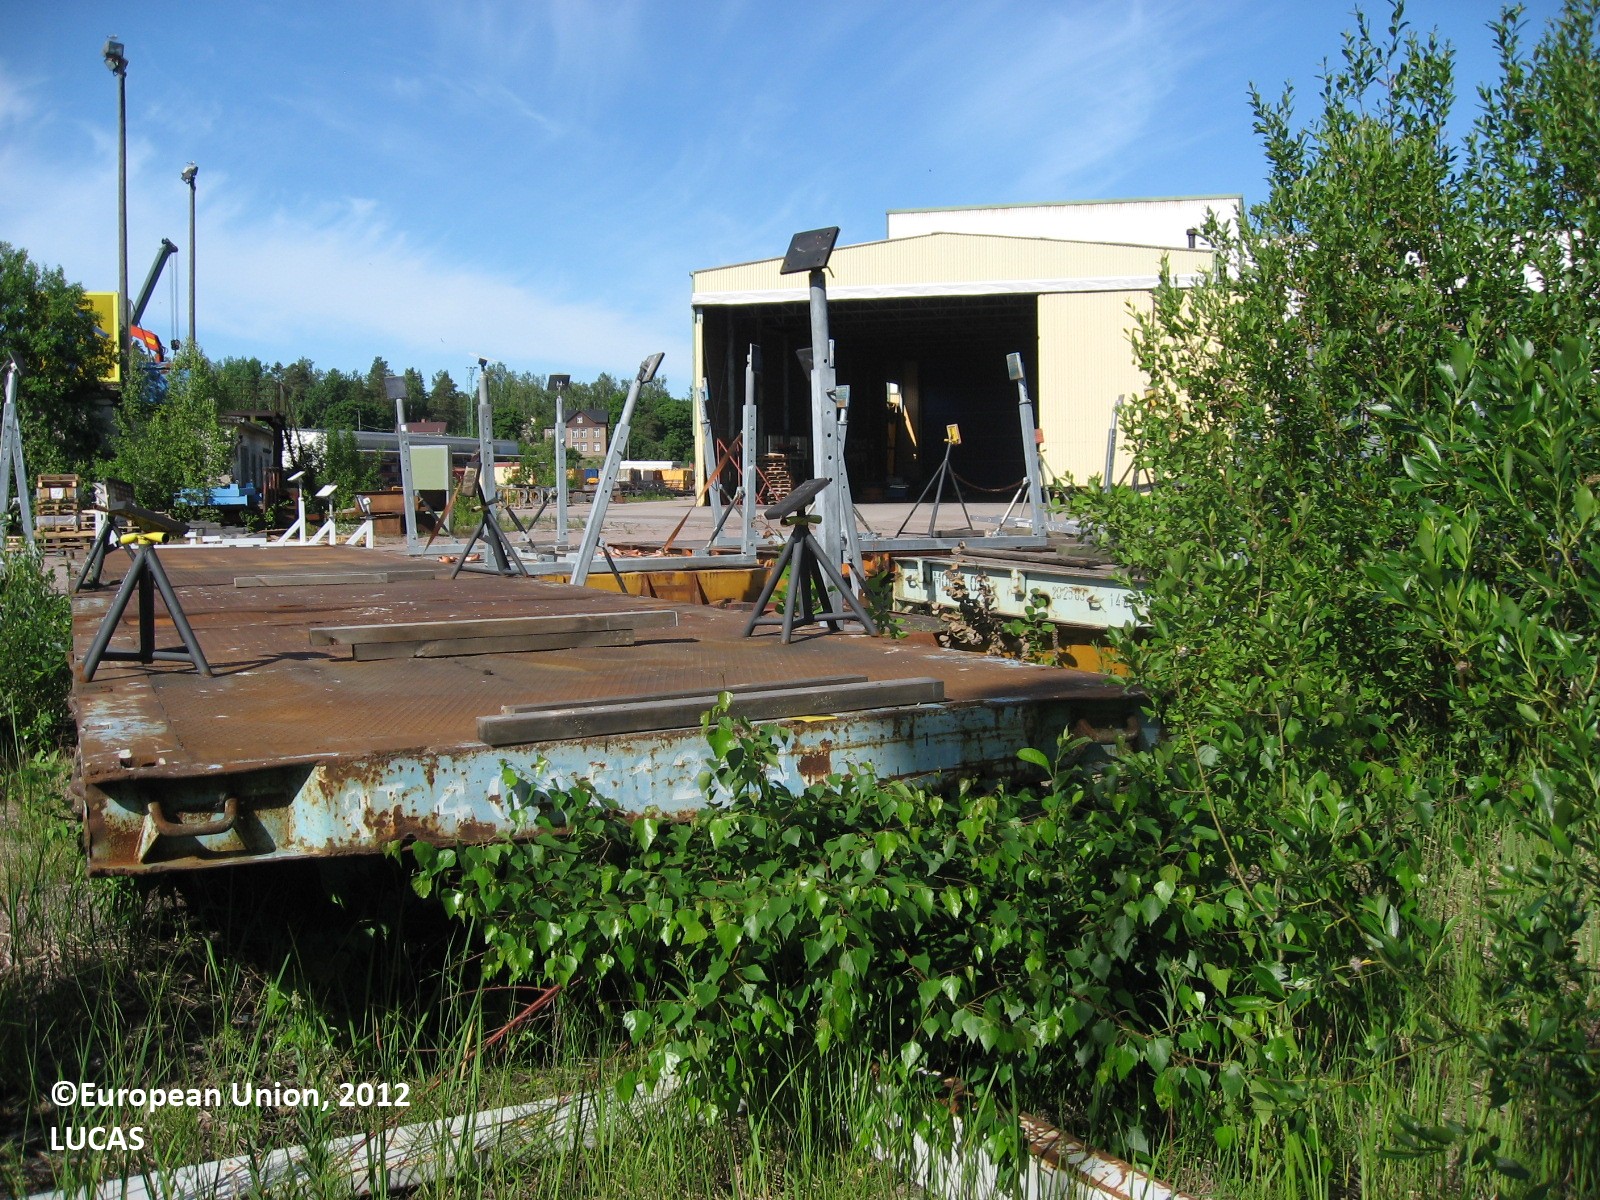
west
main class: Woodland
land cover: Broadleaved woodland
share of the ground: 50 - 75 %
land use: Water transport
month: June
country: FI
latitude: 60.4086
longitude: 26.2528
